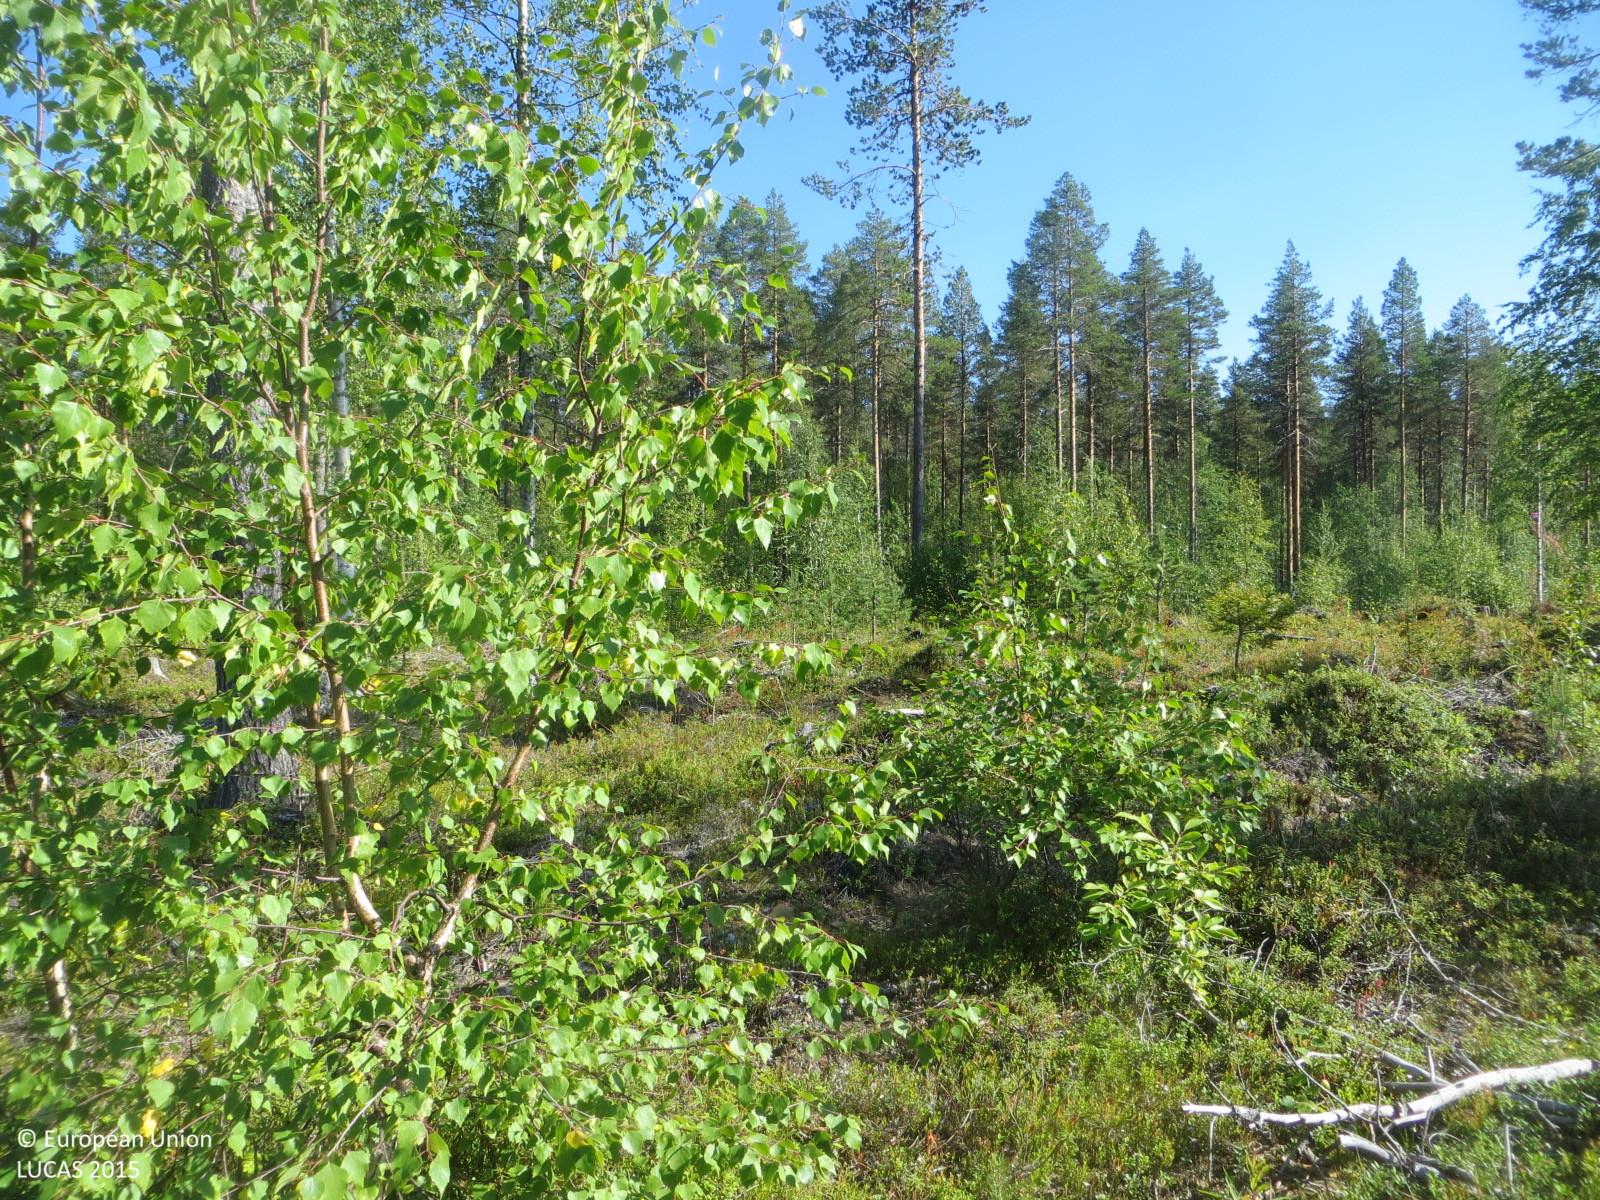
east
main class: Woodland
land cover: Pine dominated mixed woodland
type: boreal forest
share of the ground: 10 - 25 %
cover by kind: shrubs 80 %, coniferous forest trees 10 %, broadleaved forest trees 10 %
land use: Forestry
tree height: > 5 m
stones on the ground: < 10 %
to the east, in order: Pine dominated mixed woodland; Abandoned hedges; Tracks; Abandoned hedges; Ditches and canals; Pine dominated mixed woodland; Tracks; Electric lines; Pine dominated mixed woodland; Spruce dominated mixed woodland
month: August
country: FI
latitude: 67.4458
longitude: 23.7340
